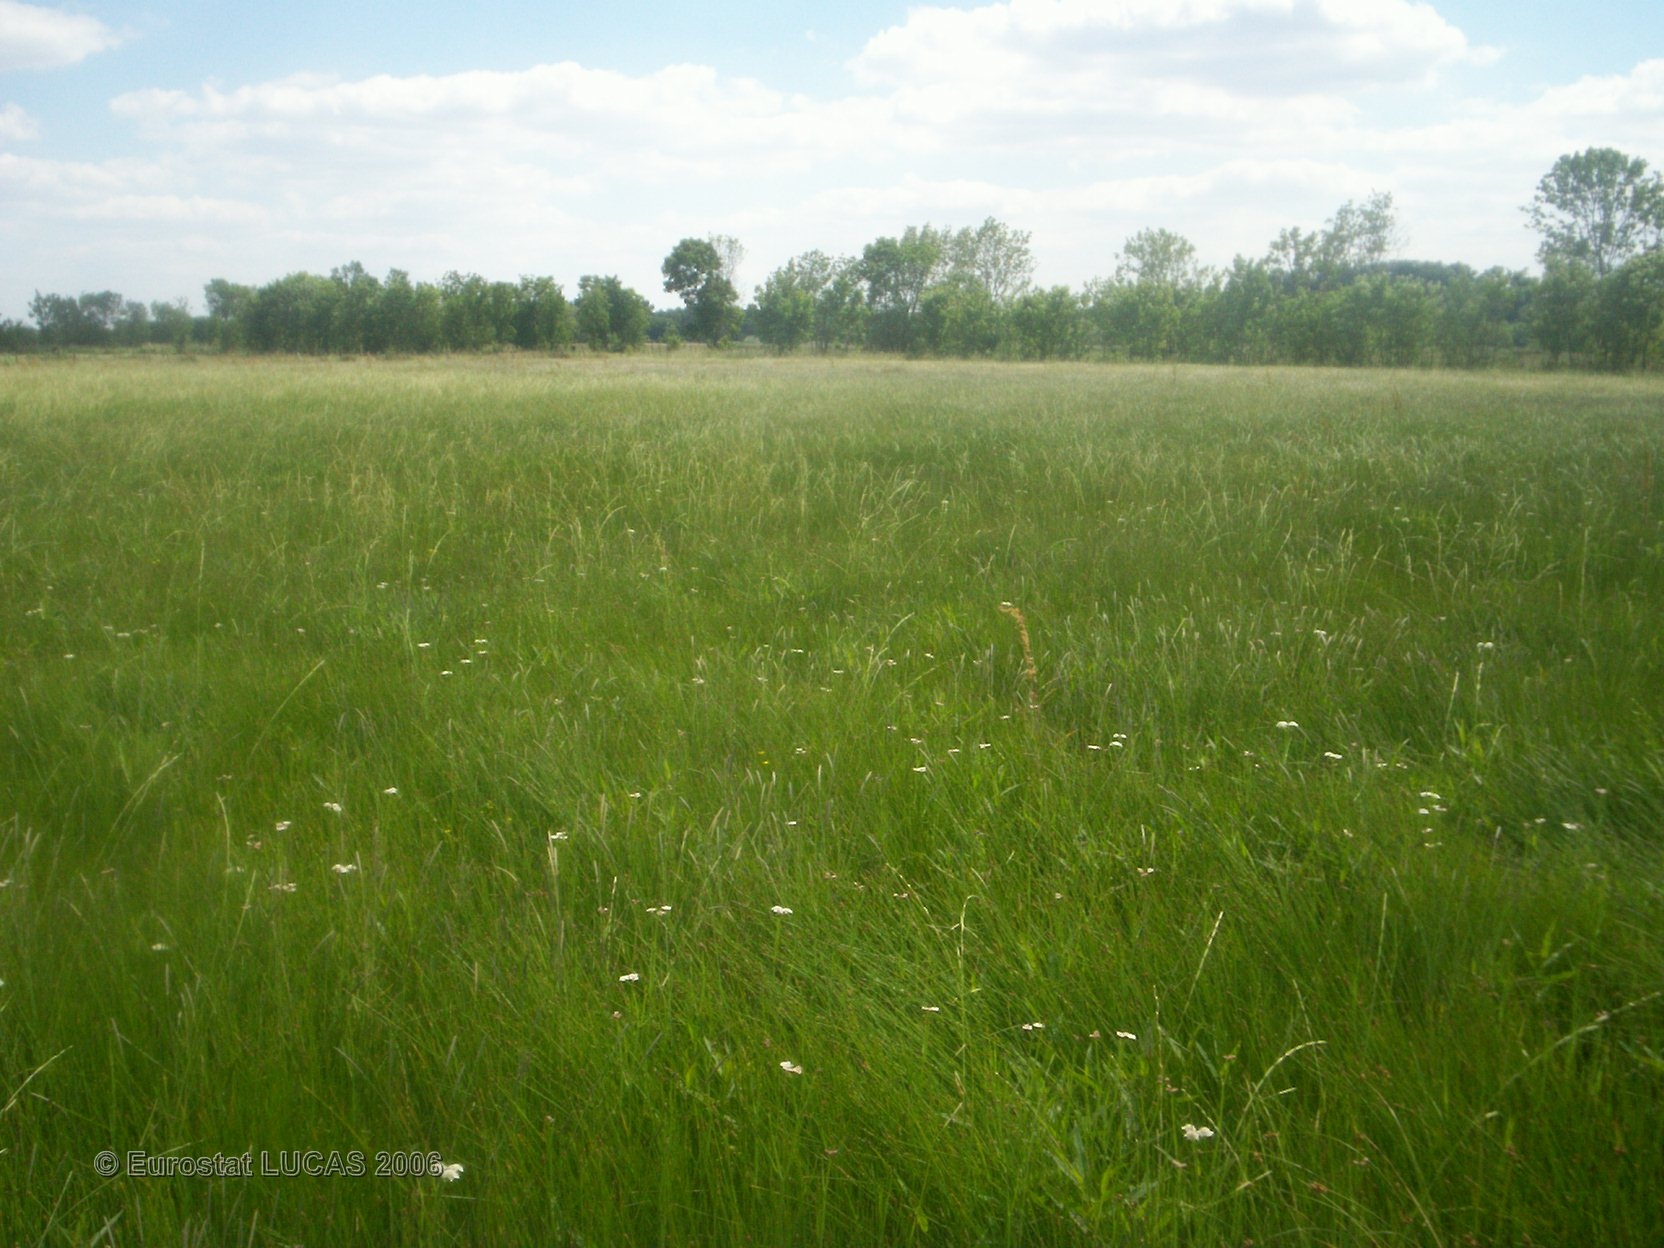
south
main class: Grassland
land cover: Grassland without tree/shrub cover
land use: Agriculture (excluding fallow land and kitchen gardens)
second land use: Wetland
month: May
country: FR
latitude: 45.8922
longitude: -0.8135
